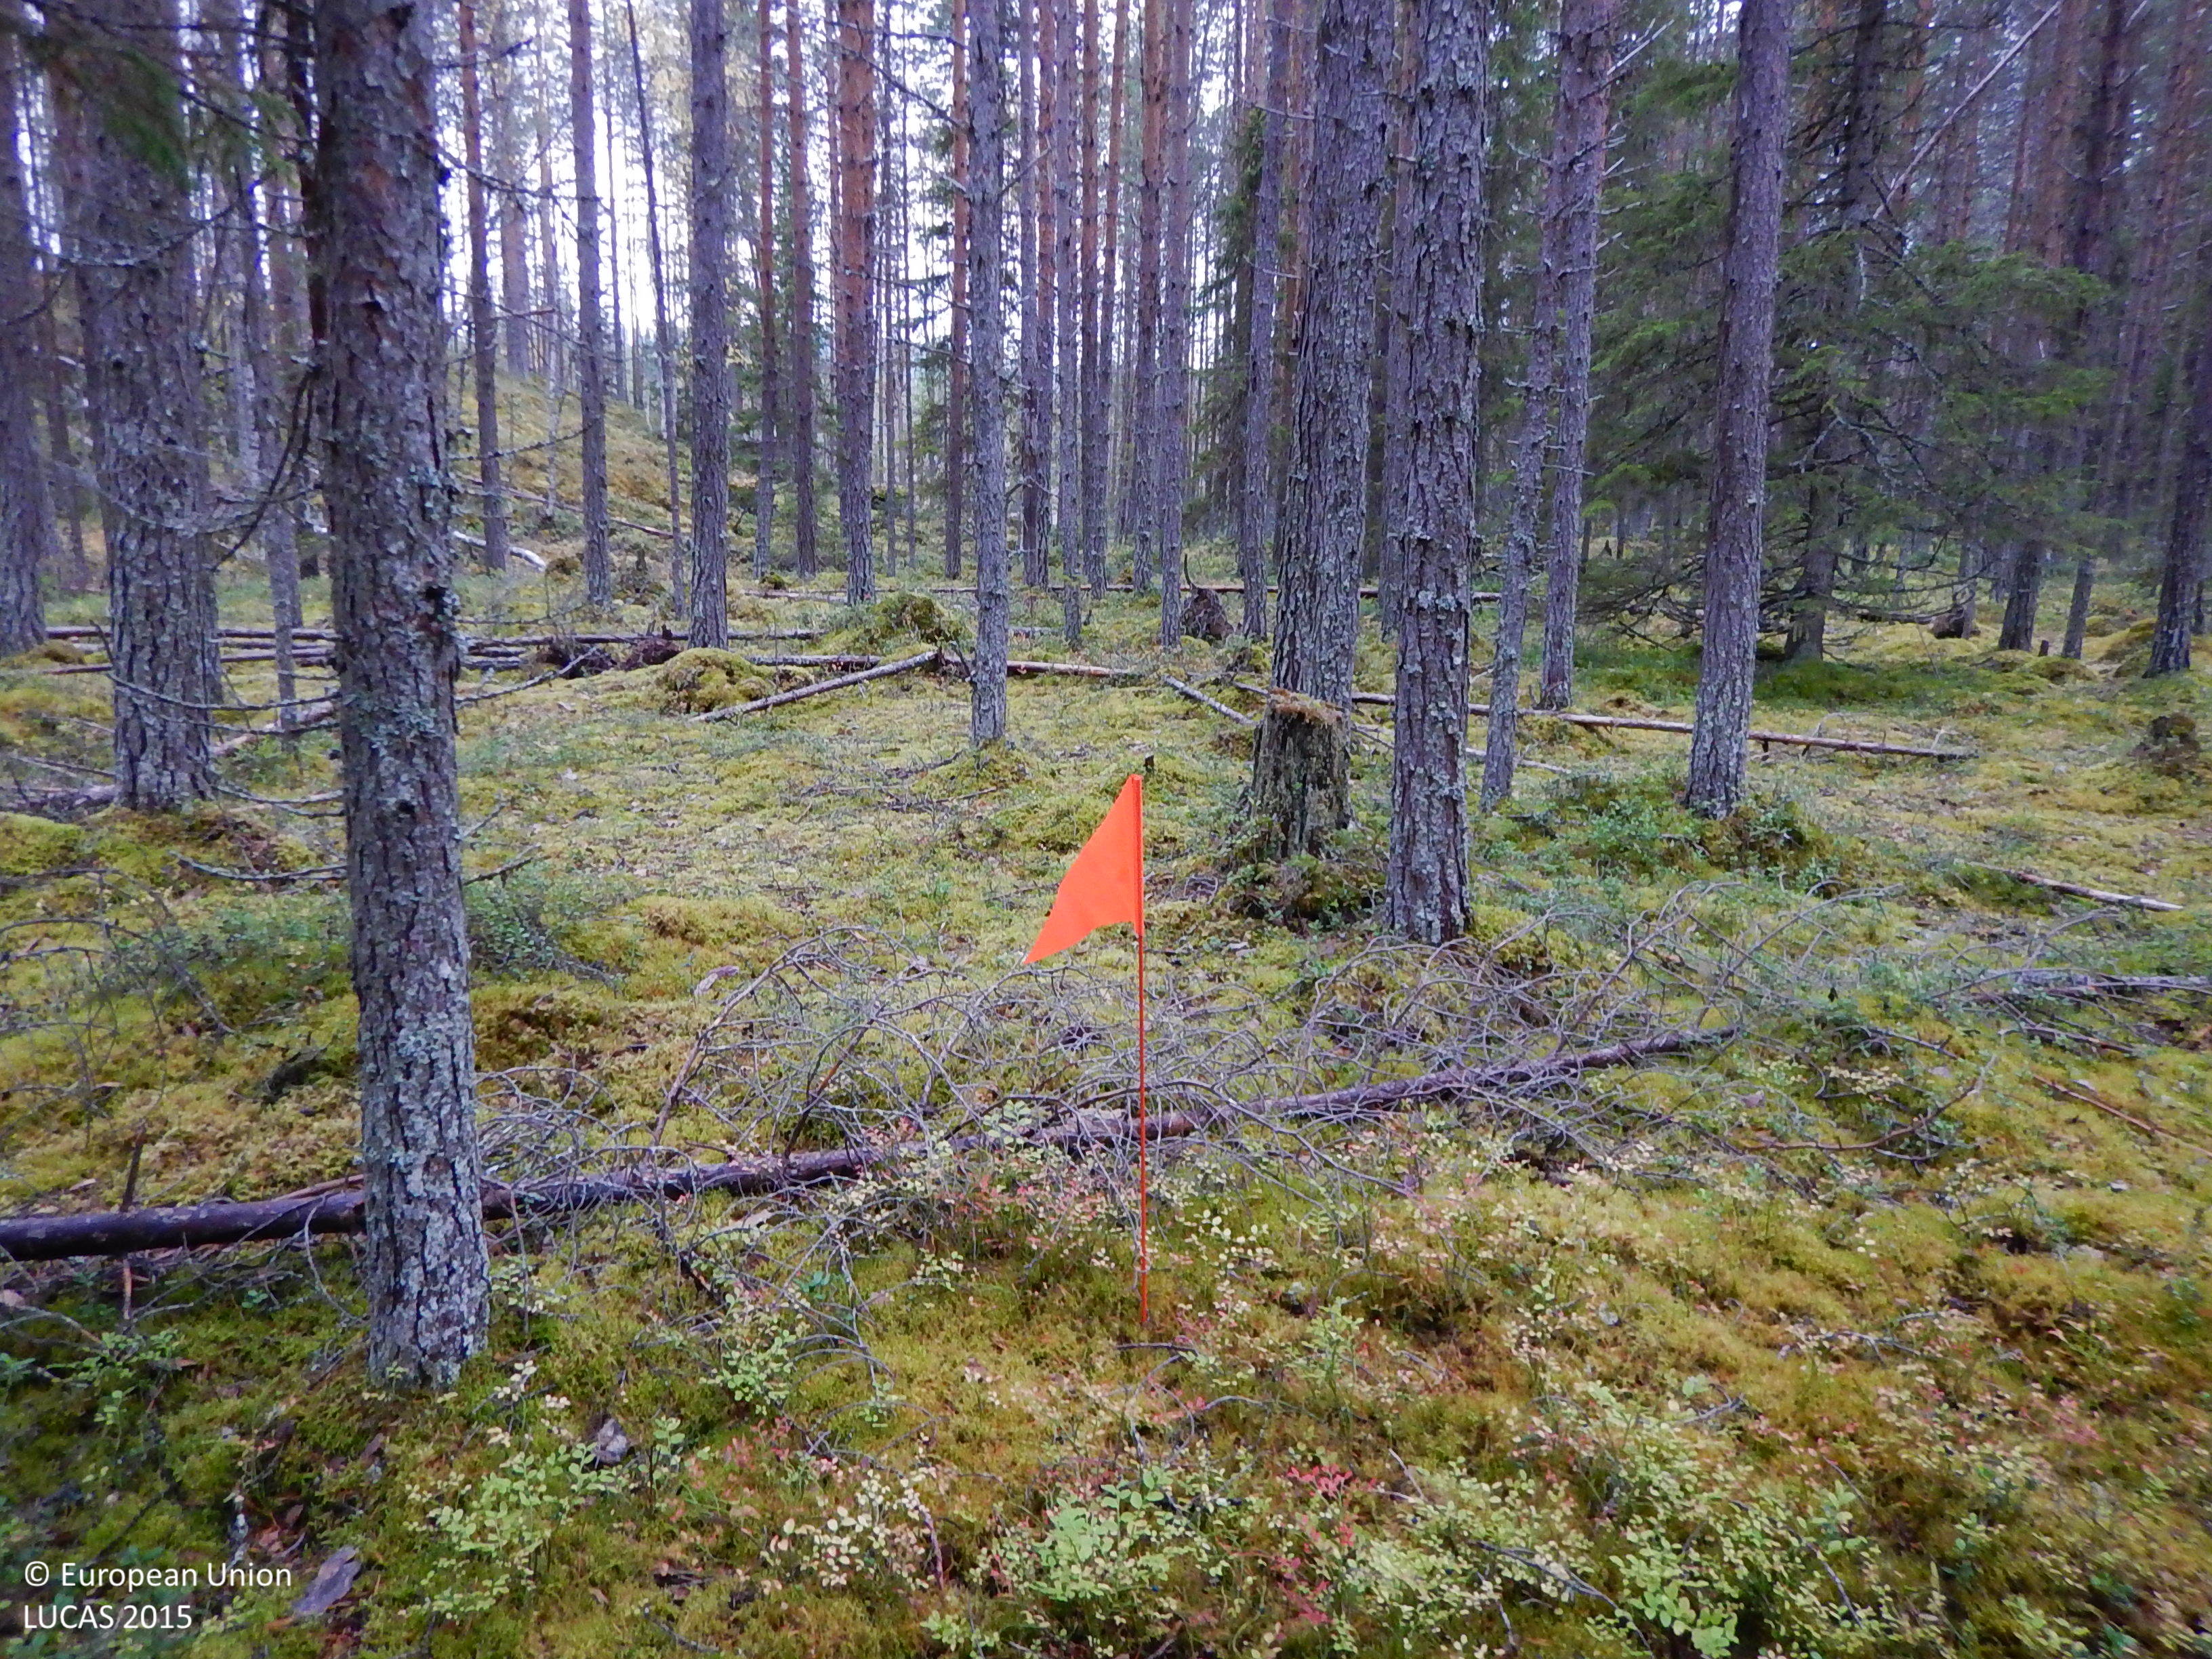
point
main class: Woodland
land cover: Pine dominated coniferous woodland
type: boreal forest
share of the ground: 50 - 75 %
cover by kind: coniferous forest trees 60 %, shrubs 15 %, lichens and mosses 15 %, herbaceous plants 10 %
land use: Forestry
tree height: > 5 m
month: September
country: SE
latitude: 65.0540
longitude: 19.2944
